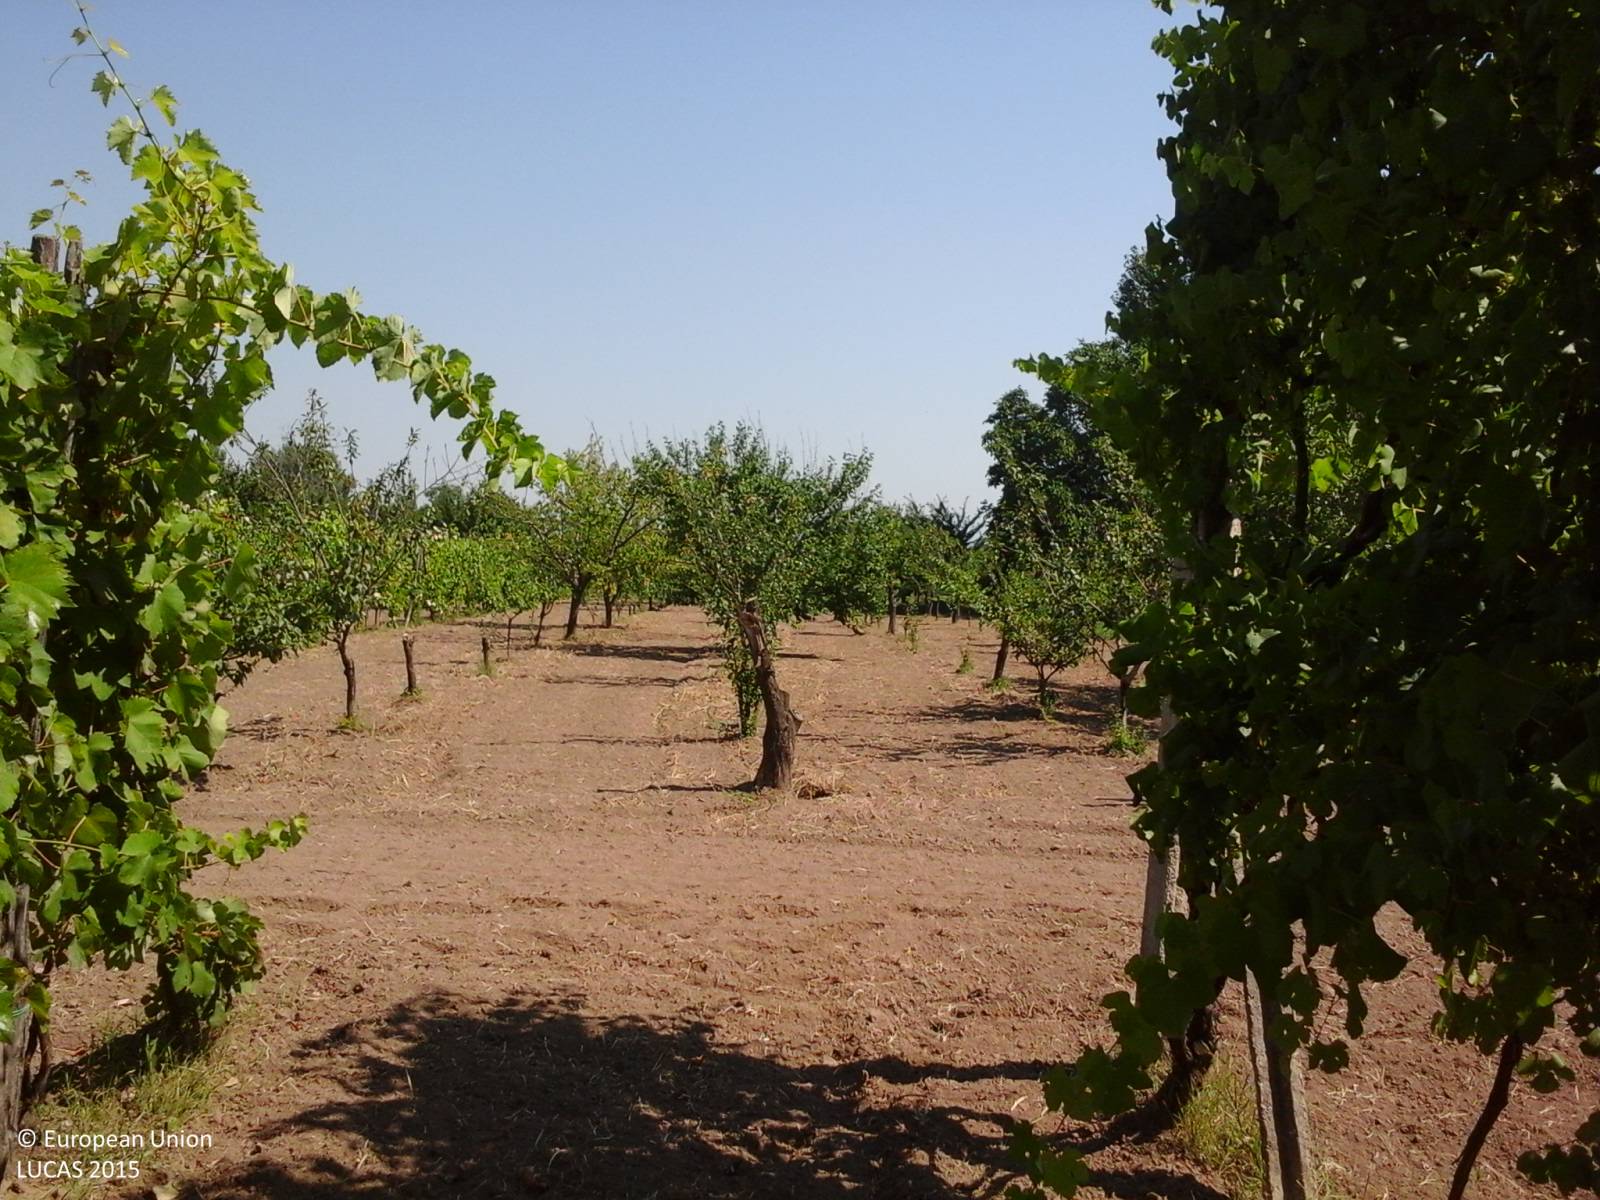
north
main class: Cropland
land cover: Vineyards
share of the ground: 50 - 75 %
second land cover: Other bare soil
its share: > 75 %
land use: Agriculture (excluding fallow land and kitchen gardens)
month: July
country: IT
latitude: 41.0106
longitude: 14.2040
